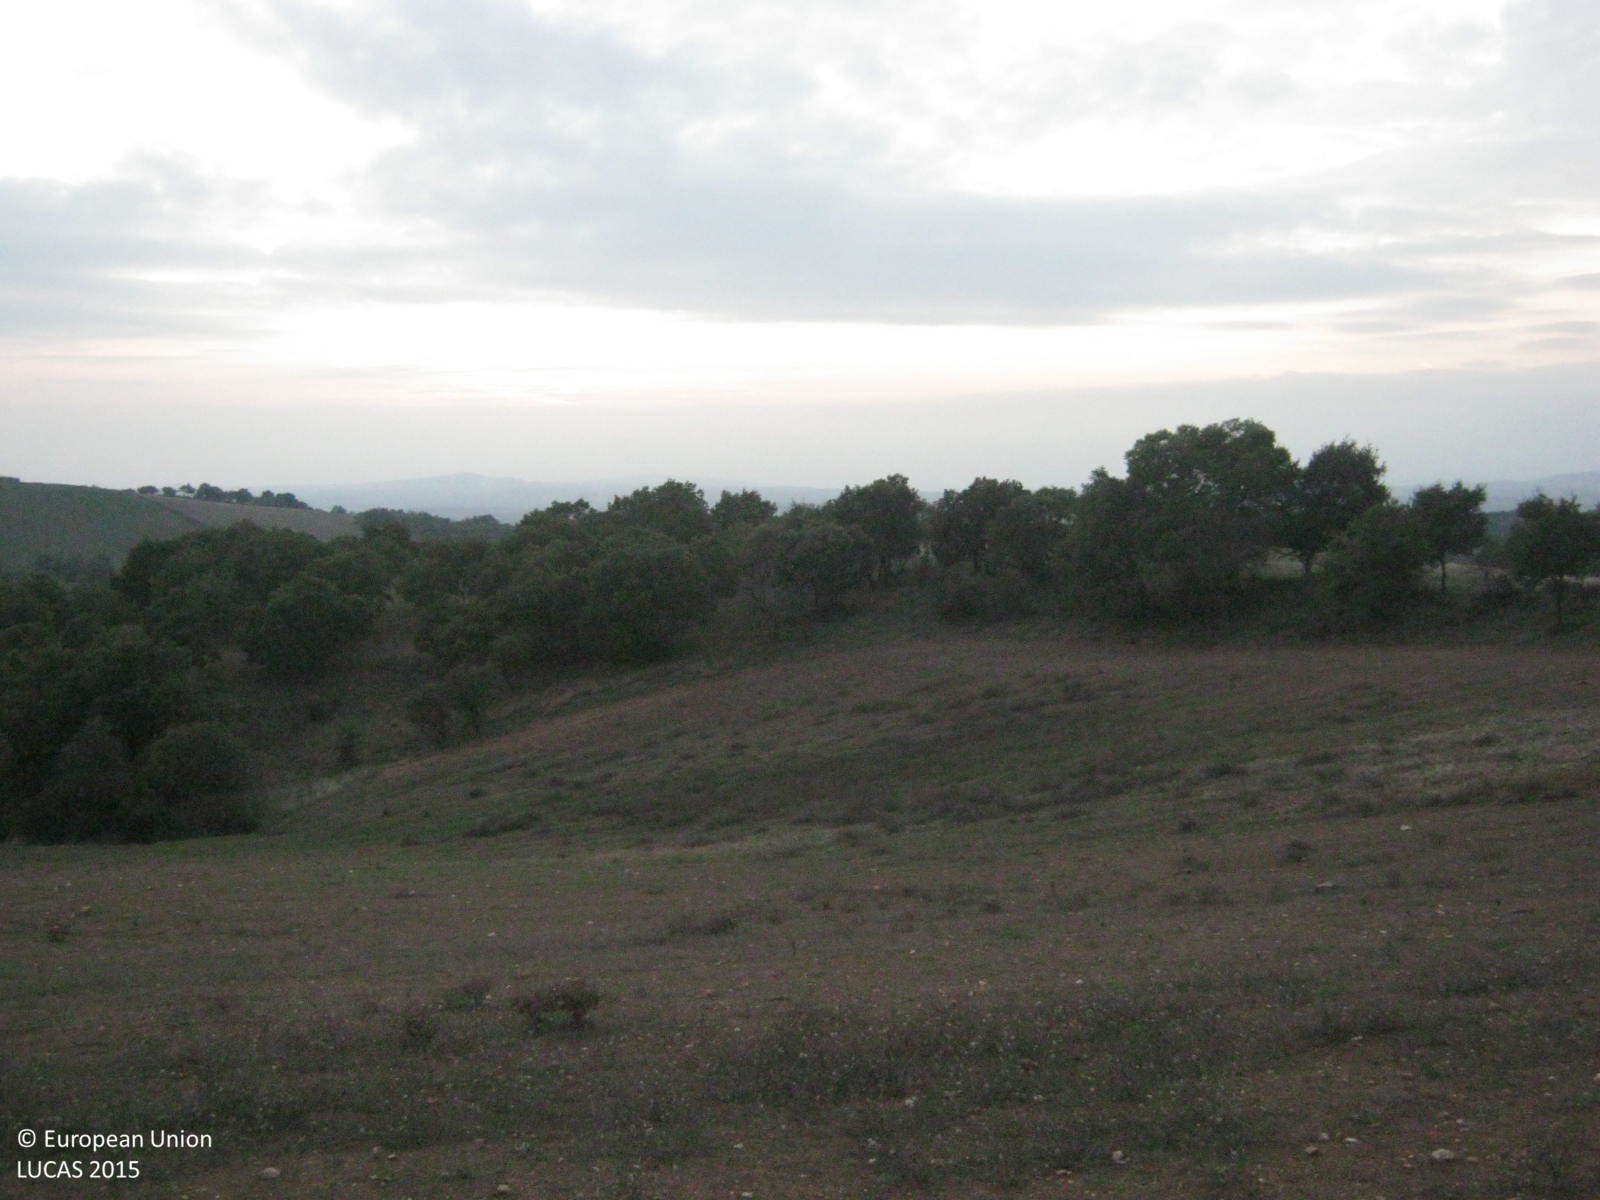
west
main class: Grassland
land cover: Grassland with sparse tree/shrub cover
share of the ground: > 75 %
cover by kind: herbaceous plants 75 %, unconsolidated bare surface 20 %, broadleaved forest trees 5 %
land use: Agriculture (excluding fallow land and kitchen gardens)
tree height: < 5 m
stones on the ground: 25 - 50 %
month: October
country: GR
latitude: 41.0249
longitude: 23.0114
